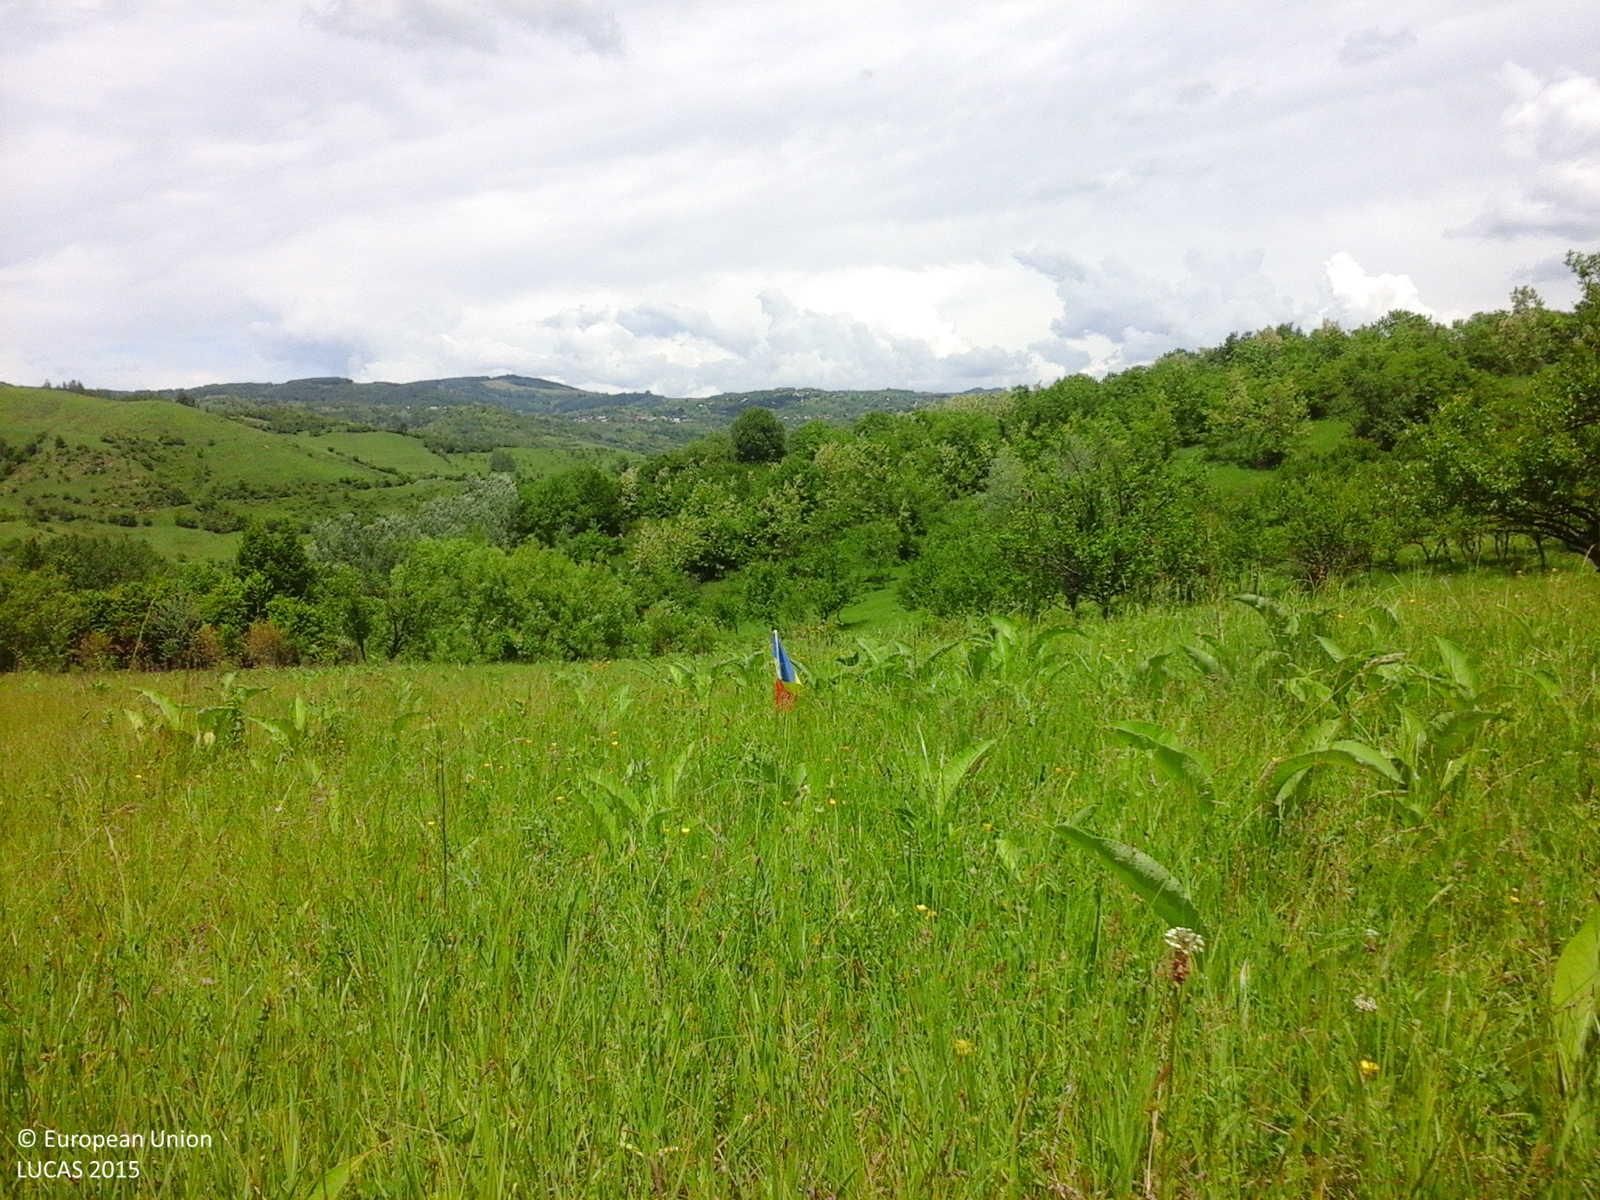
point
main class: Grassland
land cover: Grassland without tree/shrub cover
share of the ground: > 75 %
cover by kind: herbaceous plants 100 %
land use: Agriculture (excluding fallow land and kitchen gardens)
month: May
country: RO
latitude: 45.1577
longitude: 26.1023
